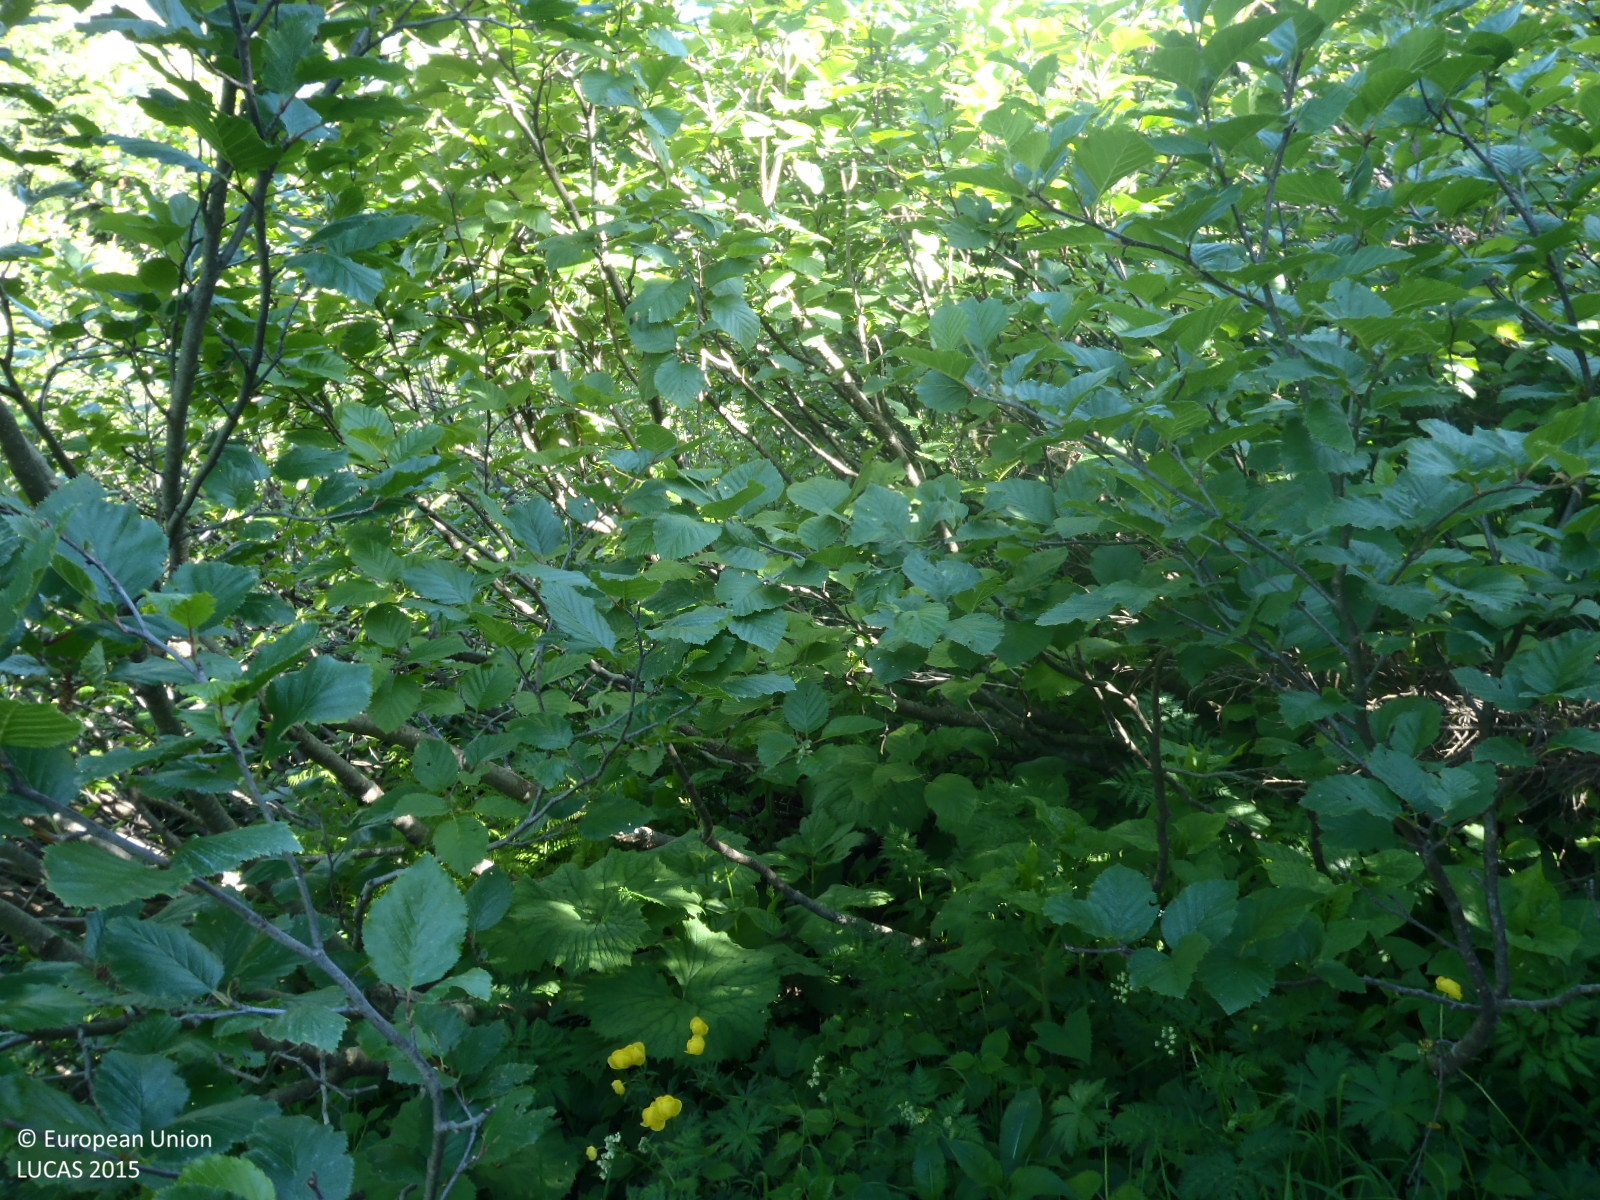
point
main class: Shrubland
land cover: Shrubland with sparse tree cover
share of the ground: > 75 %
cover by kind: shrubs 95 %, coniferous forest trees 5 %
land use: Agriculture (excluding fallow land and kitchen gardens)
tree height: > 5 m
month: June
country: AT
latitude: 47.1434
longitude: 10.1713
